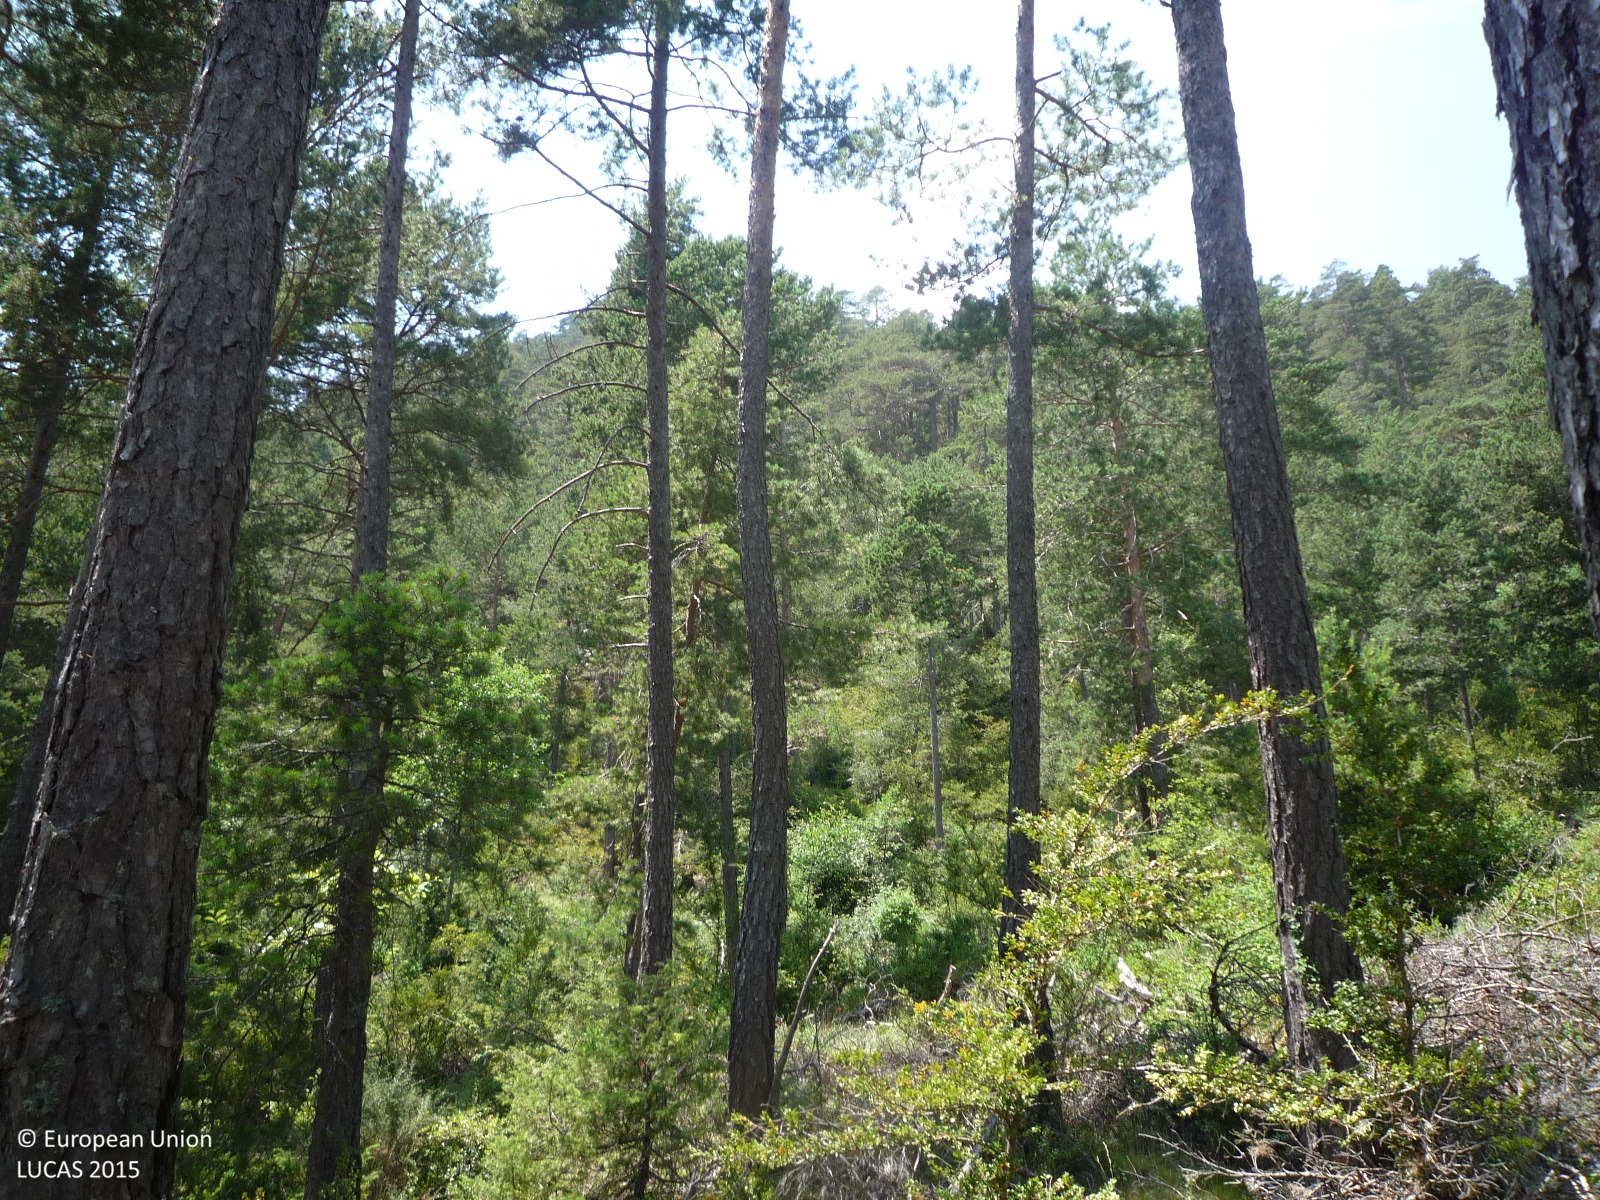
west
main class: Woodland
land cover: Pine dominated coniferous woodland
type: alpine coniferous forest
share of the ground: > 75 %
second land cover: Grassland without tree/shrub cover
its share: > 75 %
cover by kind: coniferous forest trees 80 %, herbaceous plants 20 %
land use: Forestry
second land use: Agriculture (excluding fallow land and kitchen gardens)
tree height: > 5 m
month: July
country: ES
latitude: 42.2033
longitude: 1.6912
